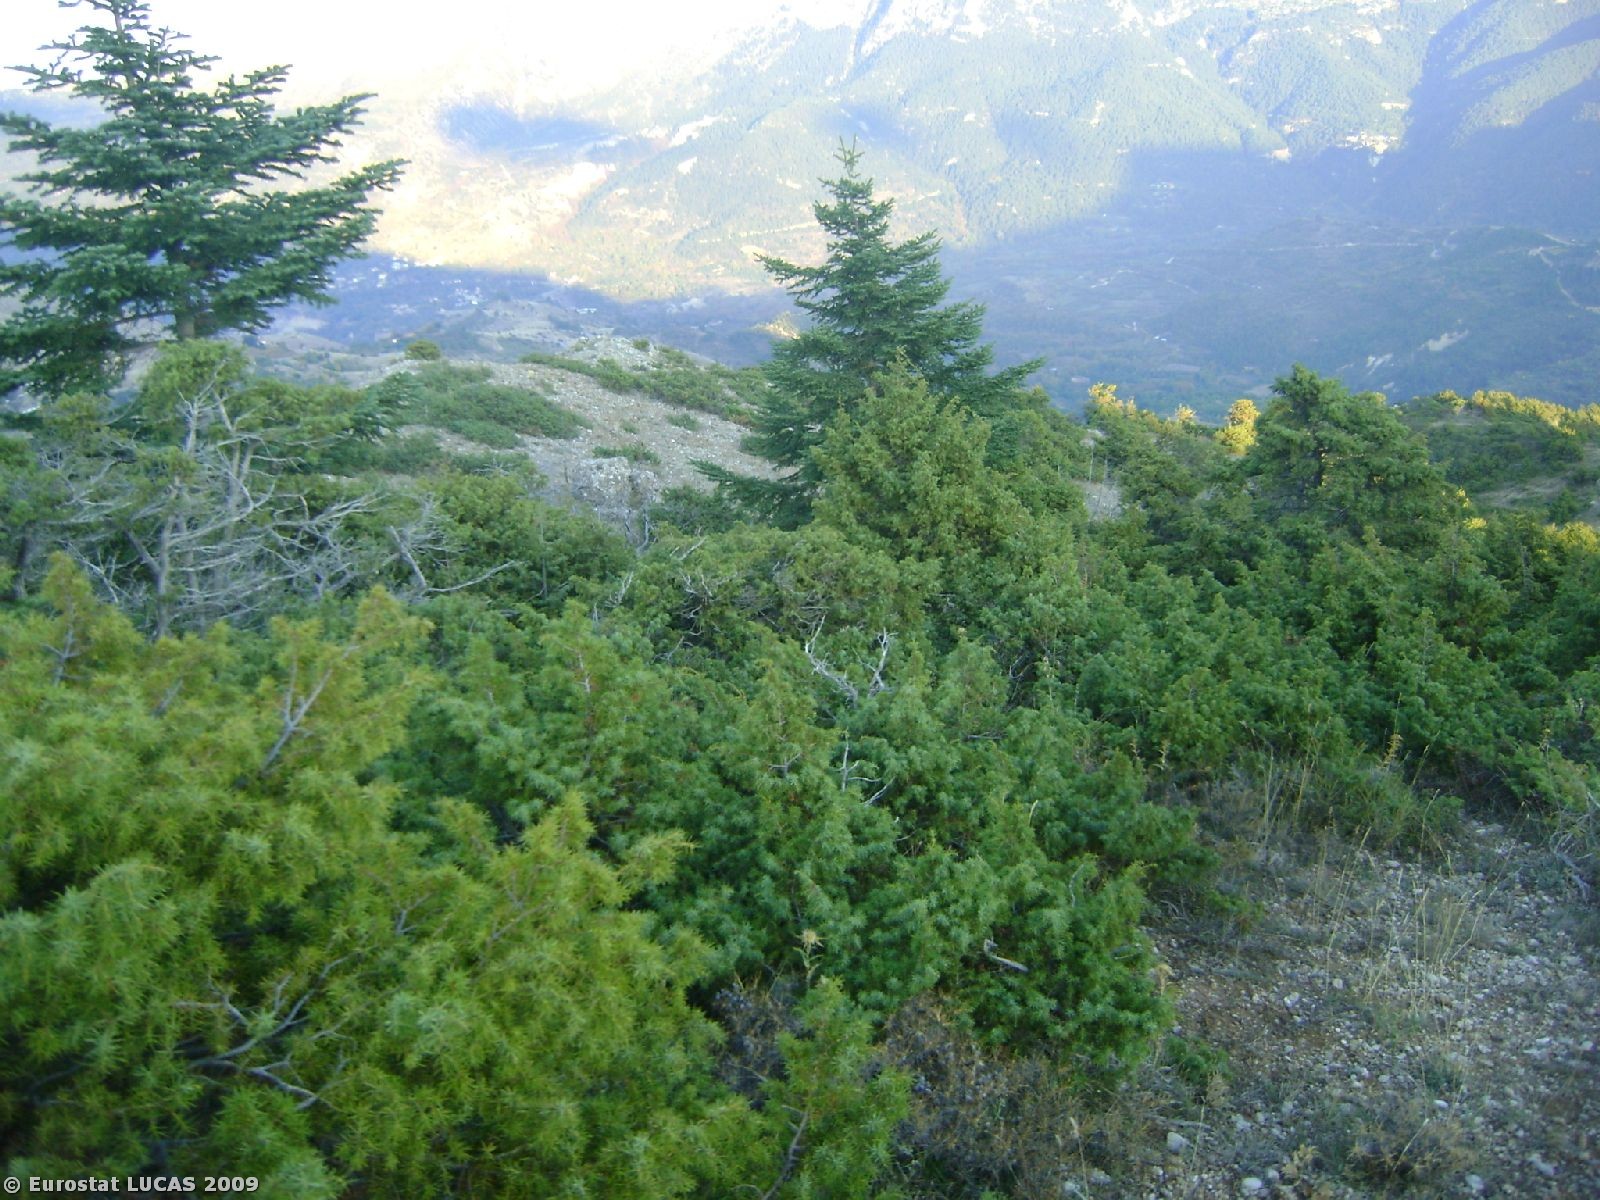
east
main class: Woodland
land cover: Broadleaved woodland
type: thermophilous deciduous forest
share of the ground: > 75 %
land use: Forestry
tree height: > 5 m
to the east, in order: Broadleaved woodland; Shrubland with sparse tree cover; Shrubland without tree cover; Rock outcrops; Shrubland without tree cover; Shrubland with sparse tree cover; Shrubland without tree cover; Rock outcrops; Shrubland without tree cover; Tracks; Bare land
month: October
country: GR
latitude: 38.0437
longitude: 22.3091
